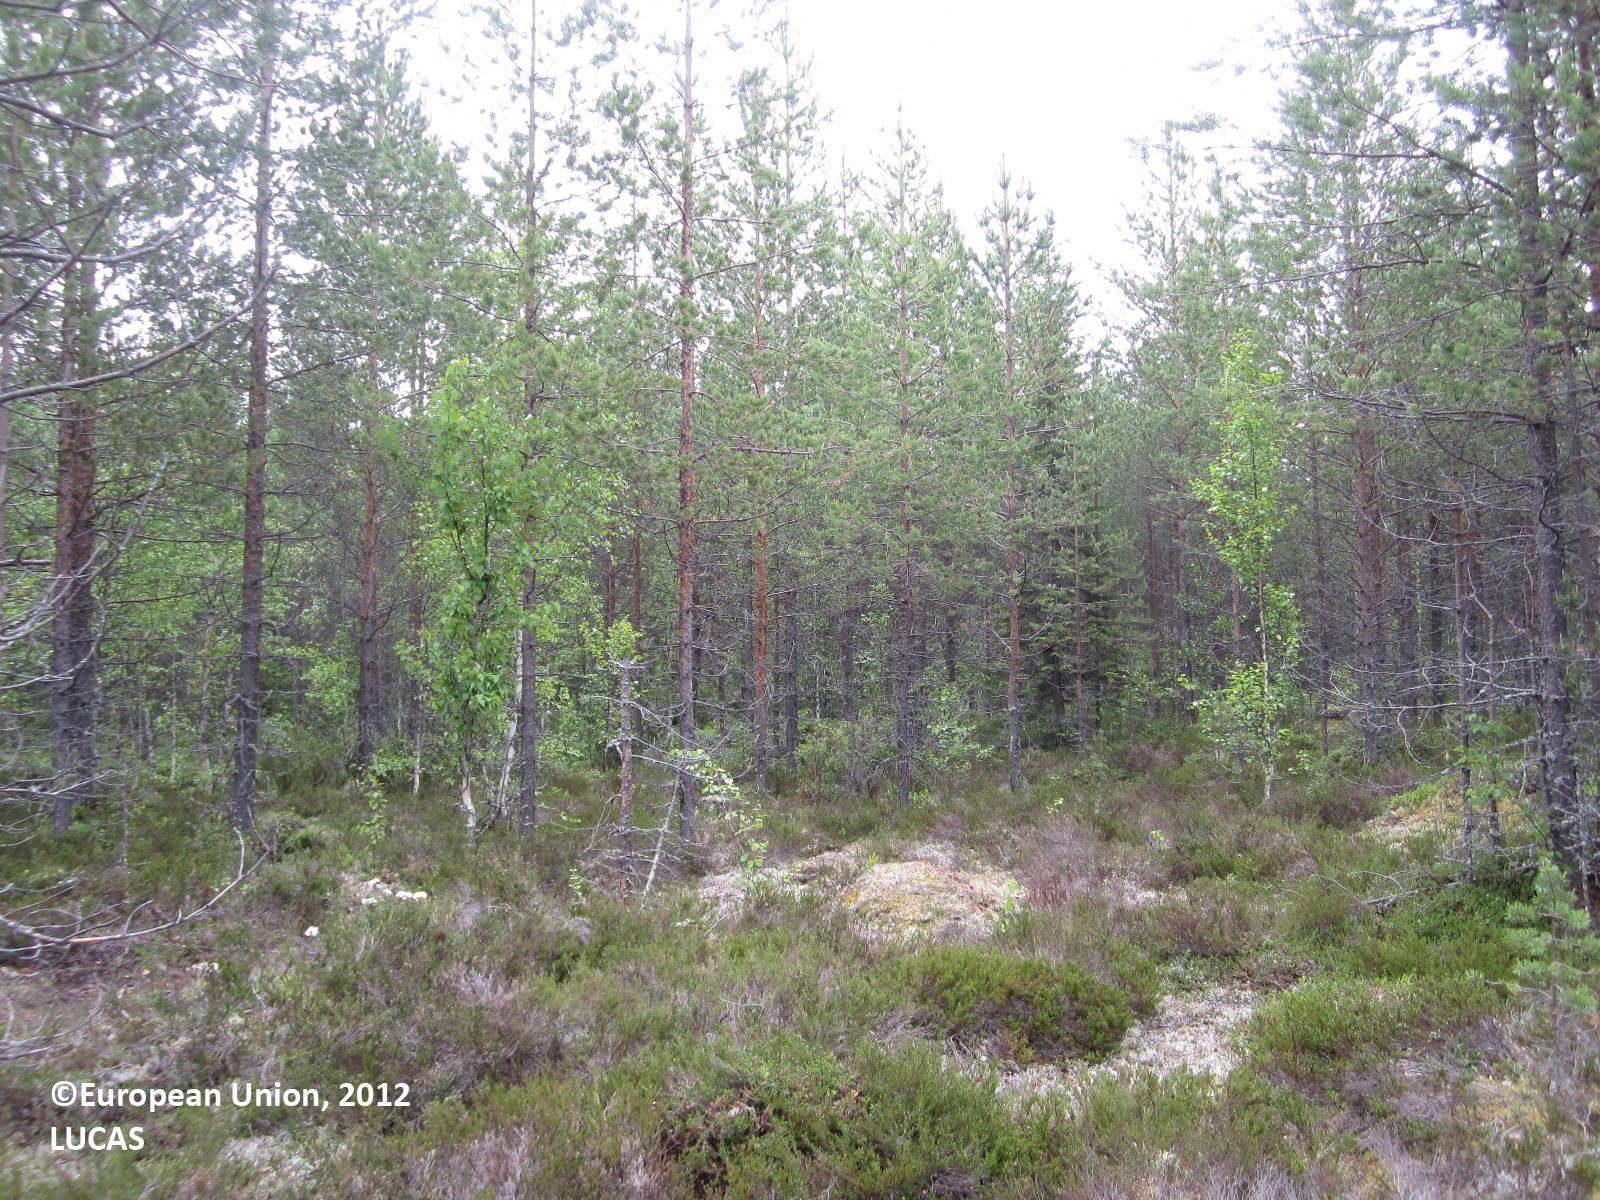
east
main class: Woodland
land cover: Pine dominated coniferous woodland
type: boreal forest
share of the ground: 25 - 50 %
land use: Forestry
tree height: > 5 m
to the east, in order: Pine dominated coniferous woodland; Lichens and moss; Pine dominated mixed woodland; Ditches and canals; Pine dominated mixed woodland; Ditches and canals; Pine dominated coniferous woodland; Ditches and canals; Pine dominated coniferous woodland; Tracks; Pine dominated coniferous woodland; Spontaneously vegetated surfaces; Grassland with sparse tree/shrub cover
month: June
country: FI
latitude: 64.3964
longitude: 29.5681
